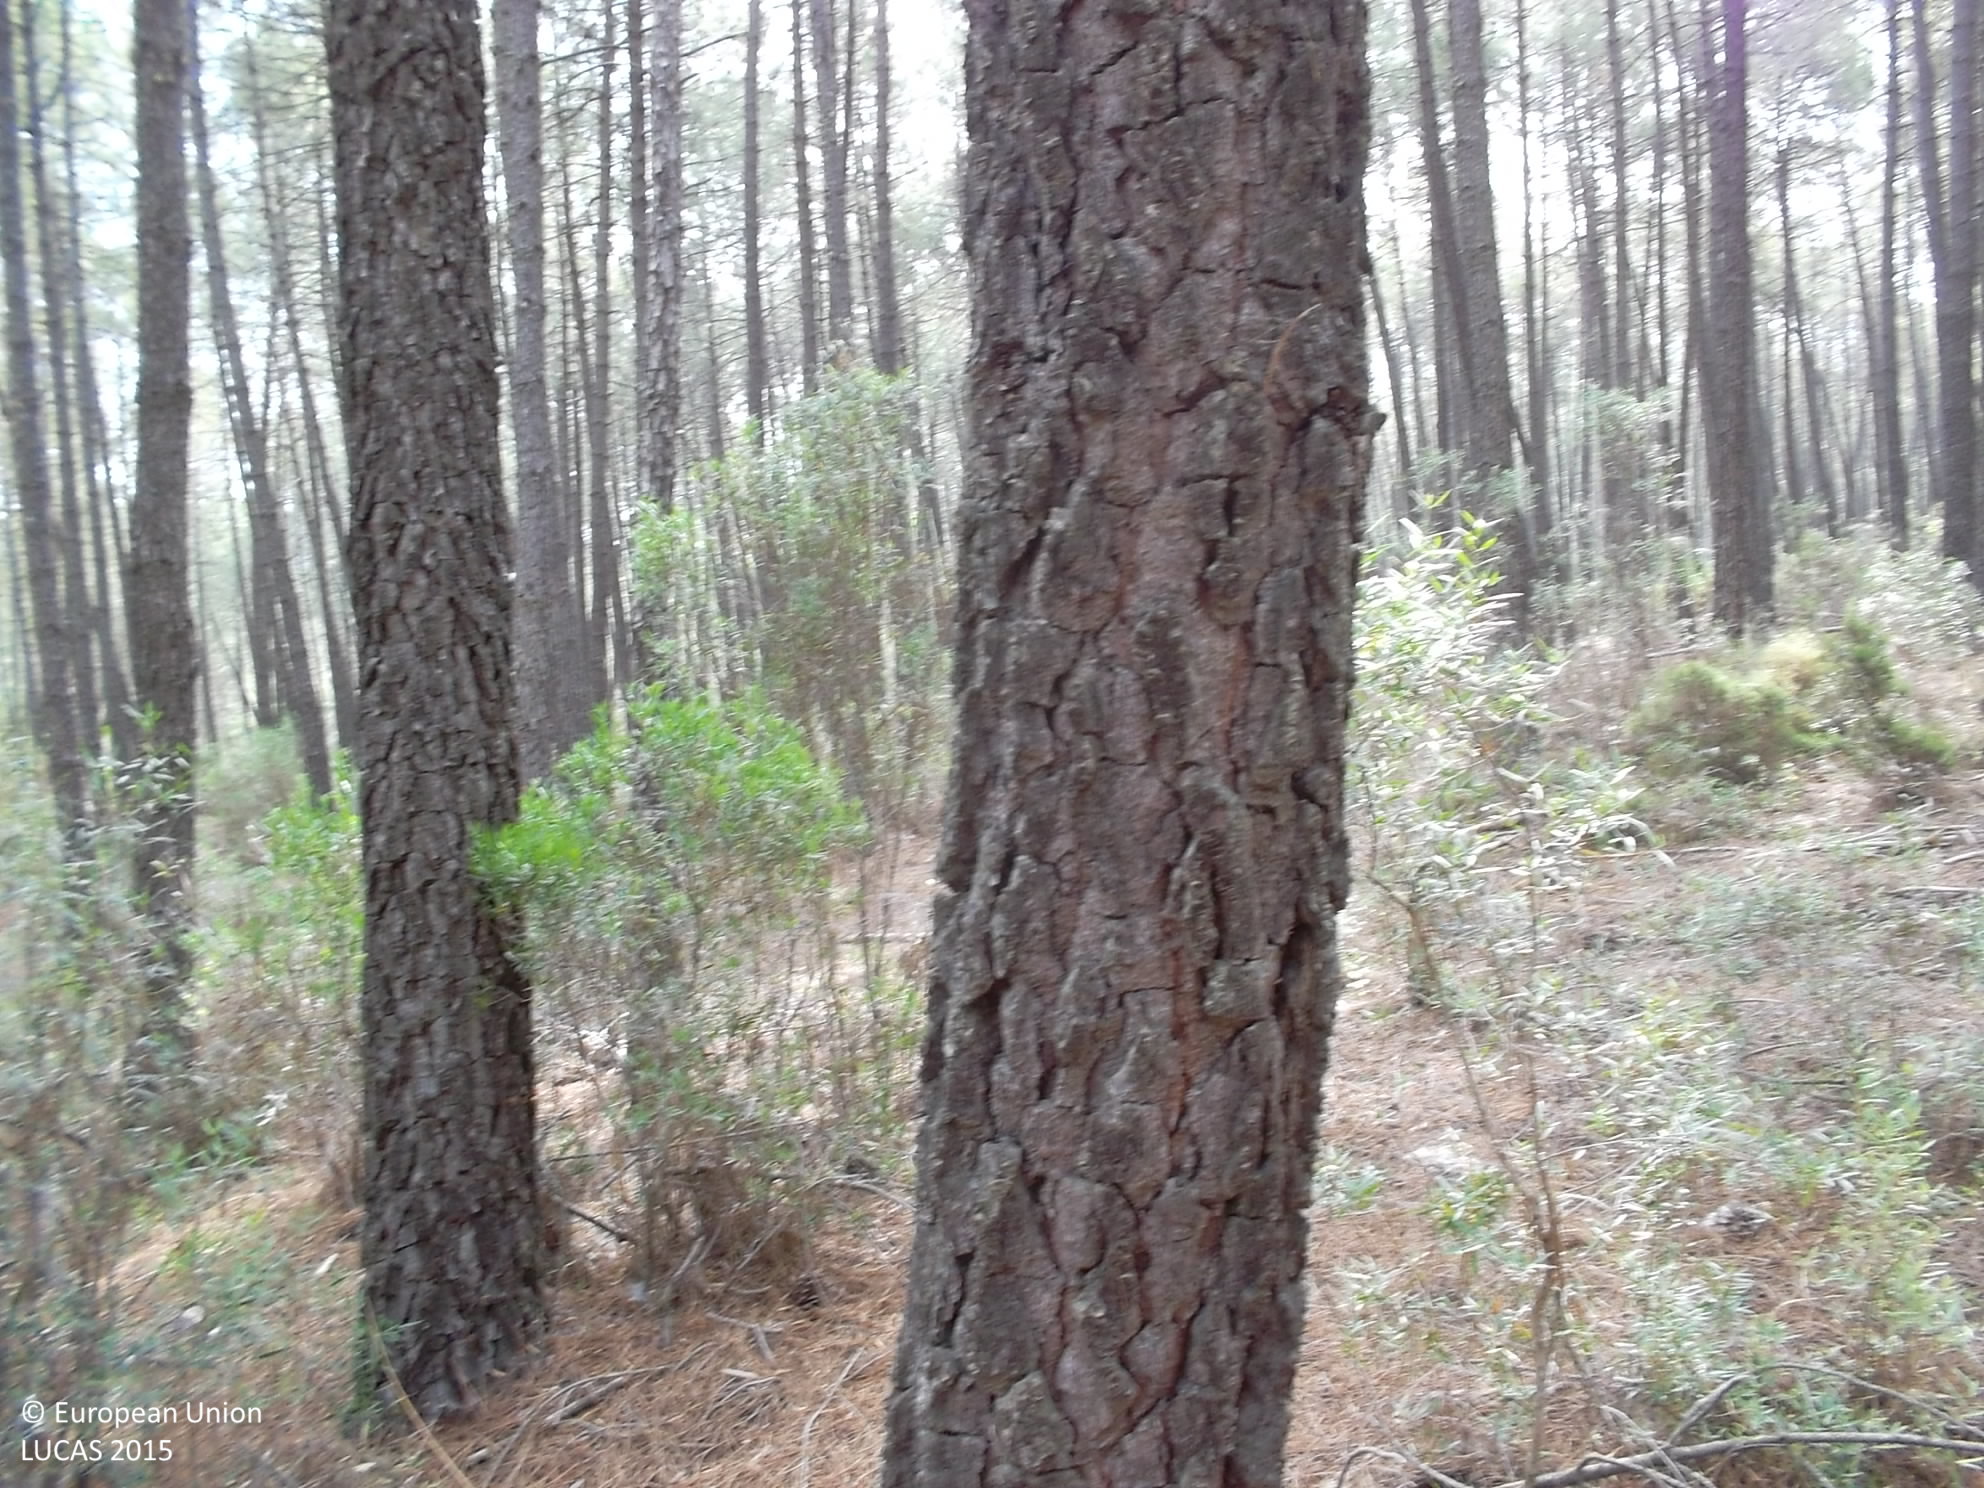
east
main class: Woodland
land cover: Pine dominated coniferous woodland
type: coniferous forest of the mediterranean region
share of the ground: > 75 %
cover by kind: coniferous forest trees 80 %, broadleaved forest trees 20 %
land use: Forestry
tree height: > 5 m
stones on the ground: 10 - 25 %
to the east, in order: Pine dominated coniferous woodland
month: June
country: ES
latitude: 39.1721
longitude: -4.8166
